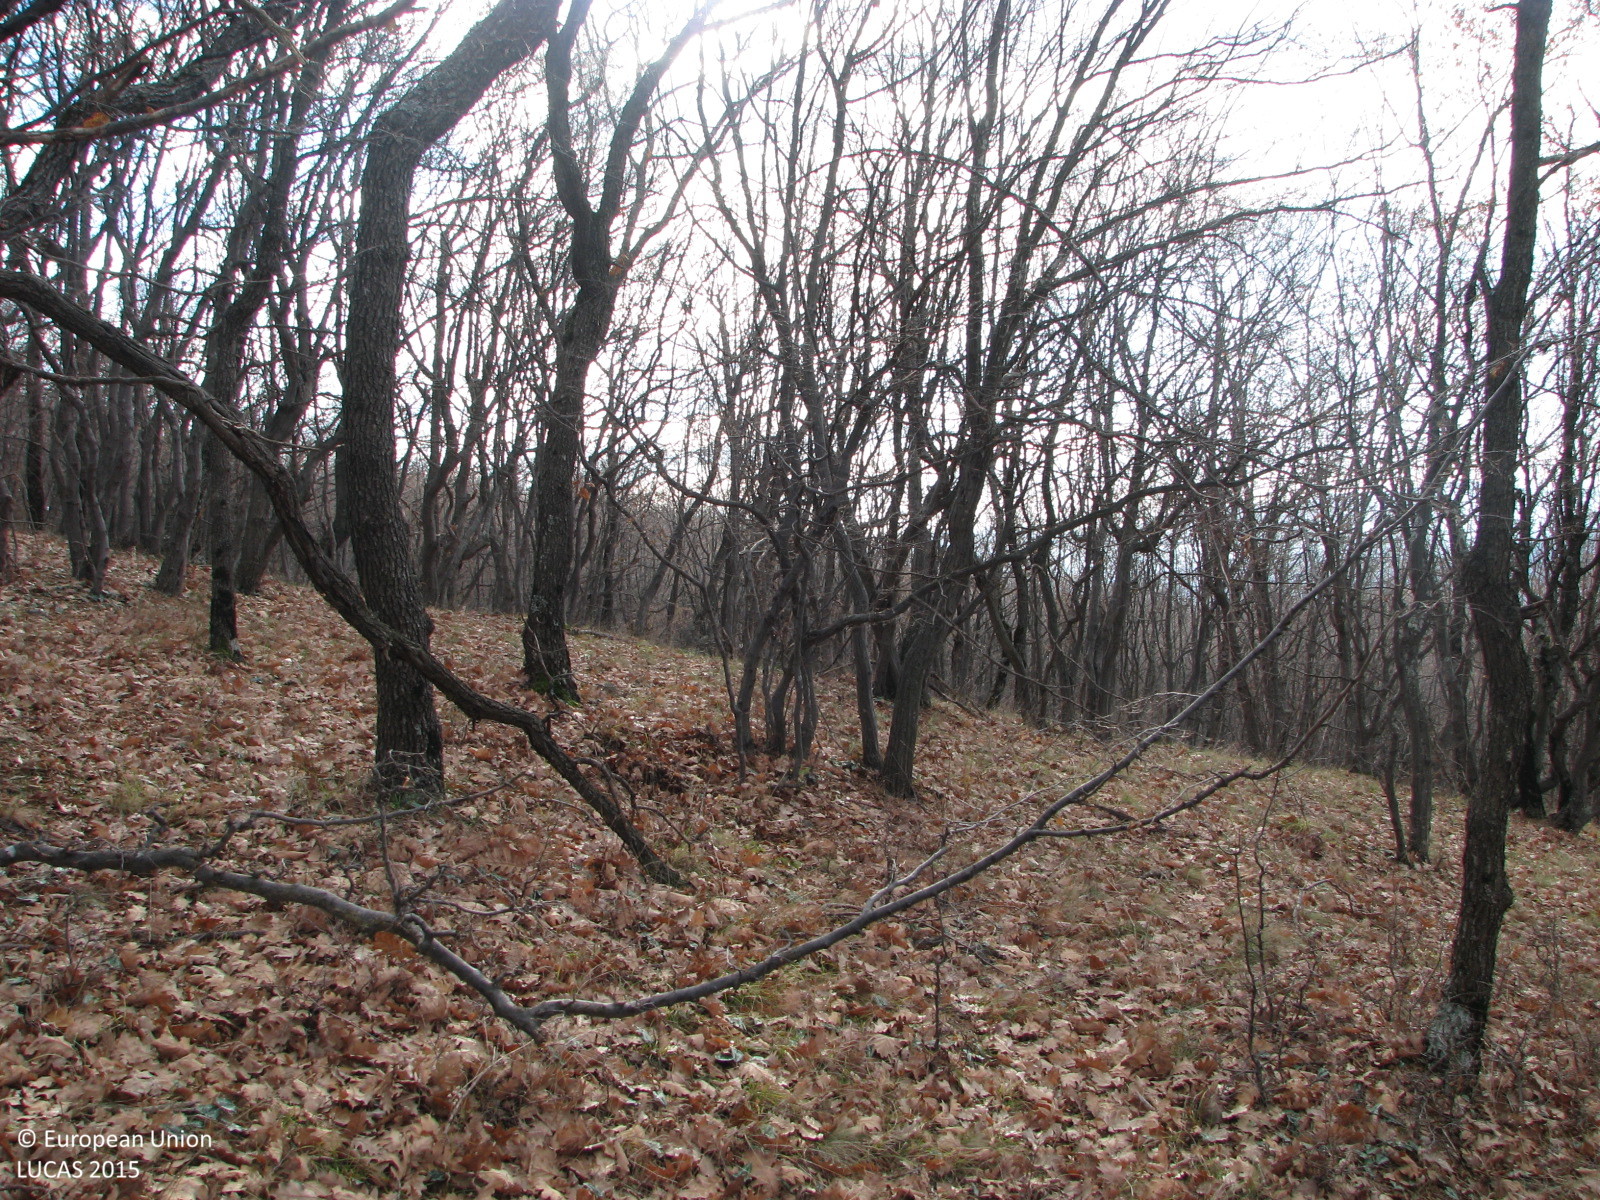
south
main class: Woodland
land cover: Broadleaved woodland
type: mesophytic deciduous forest
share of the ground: > 75 %
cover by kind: broadleaved forest trees 85 %, herbaceous plants 10 %, unconsolidated bare surface 5 %
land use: Semi-natural and natural areas not in use
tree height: < 5 m
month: December
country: BG
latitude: 42.5428
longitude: 24.0844
